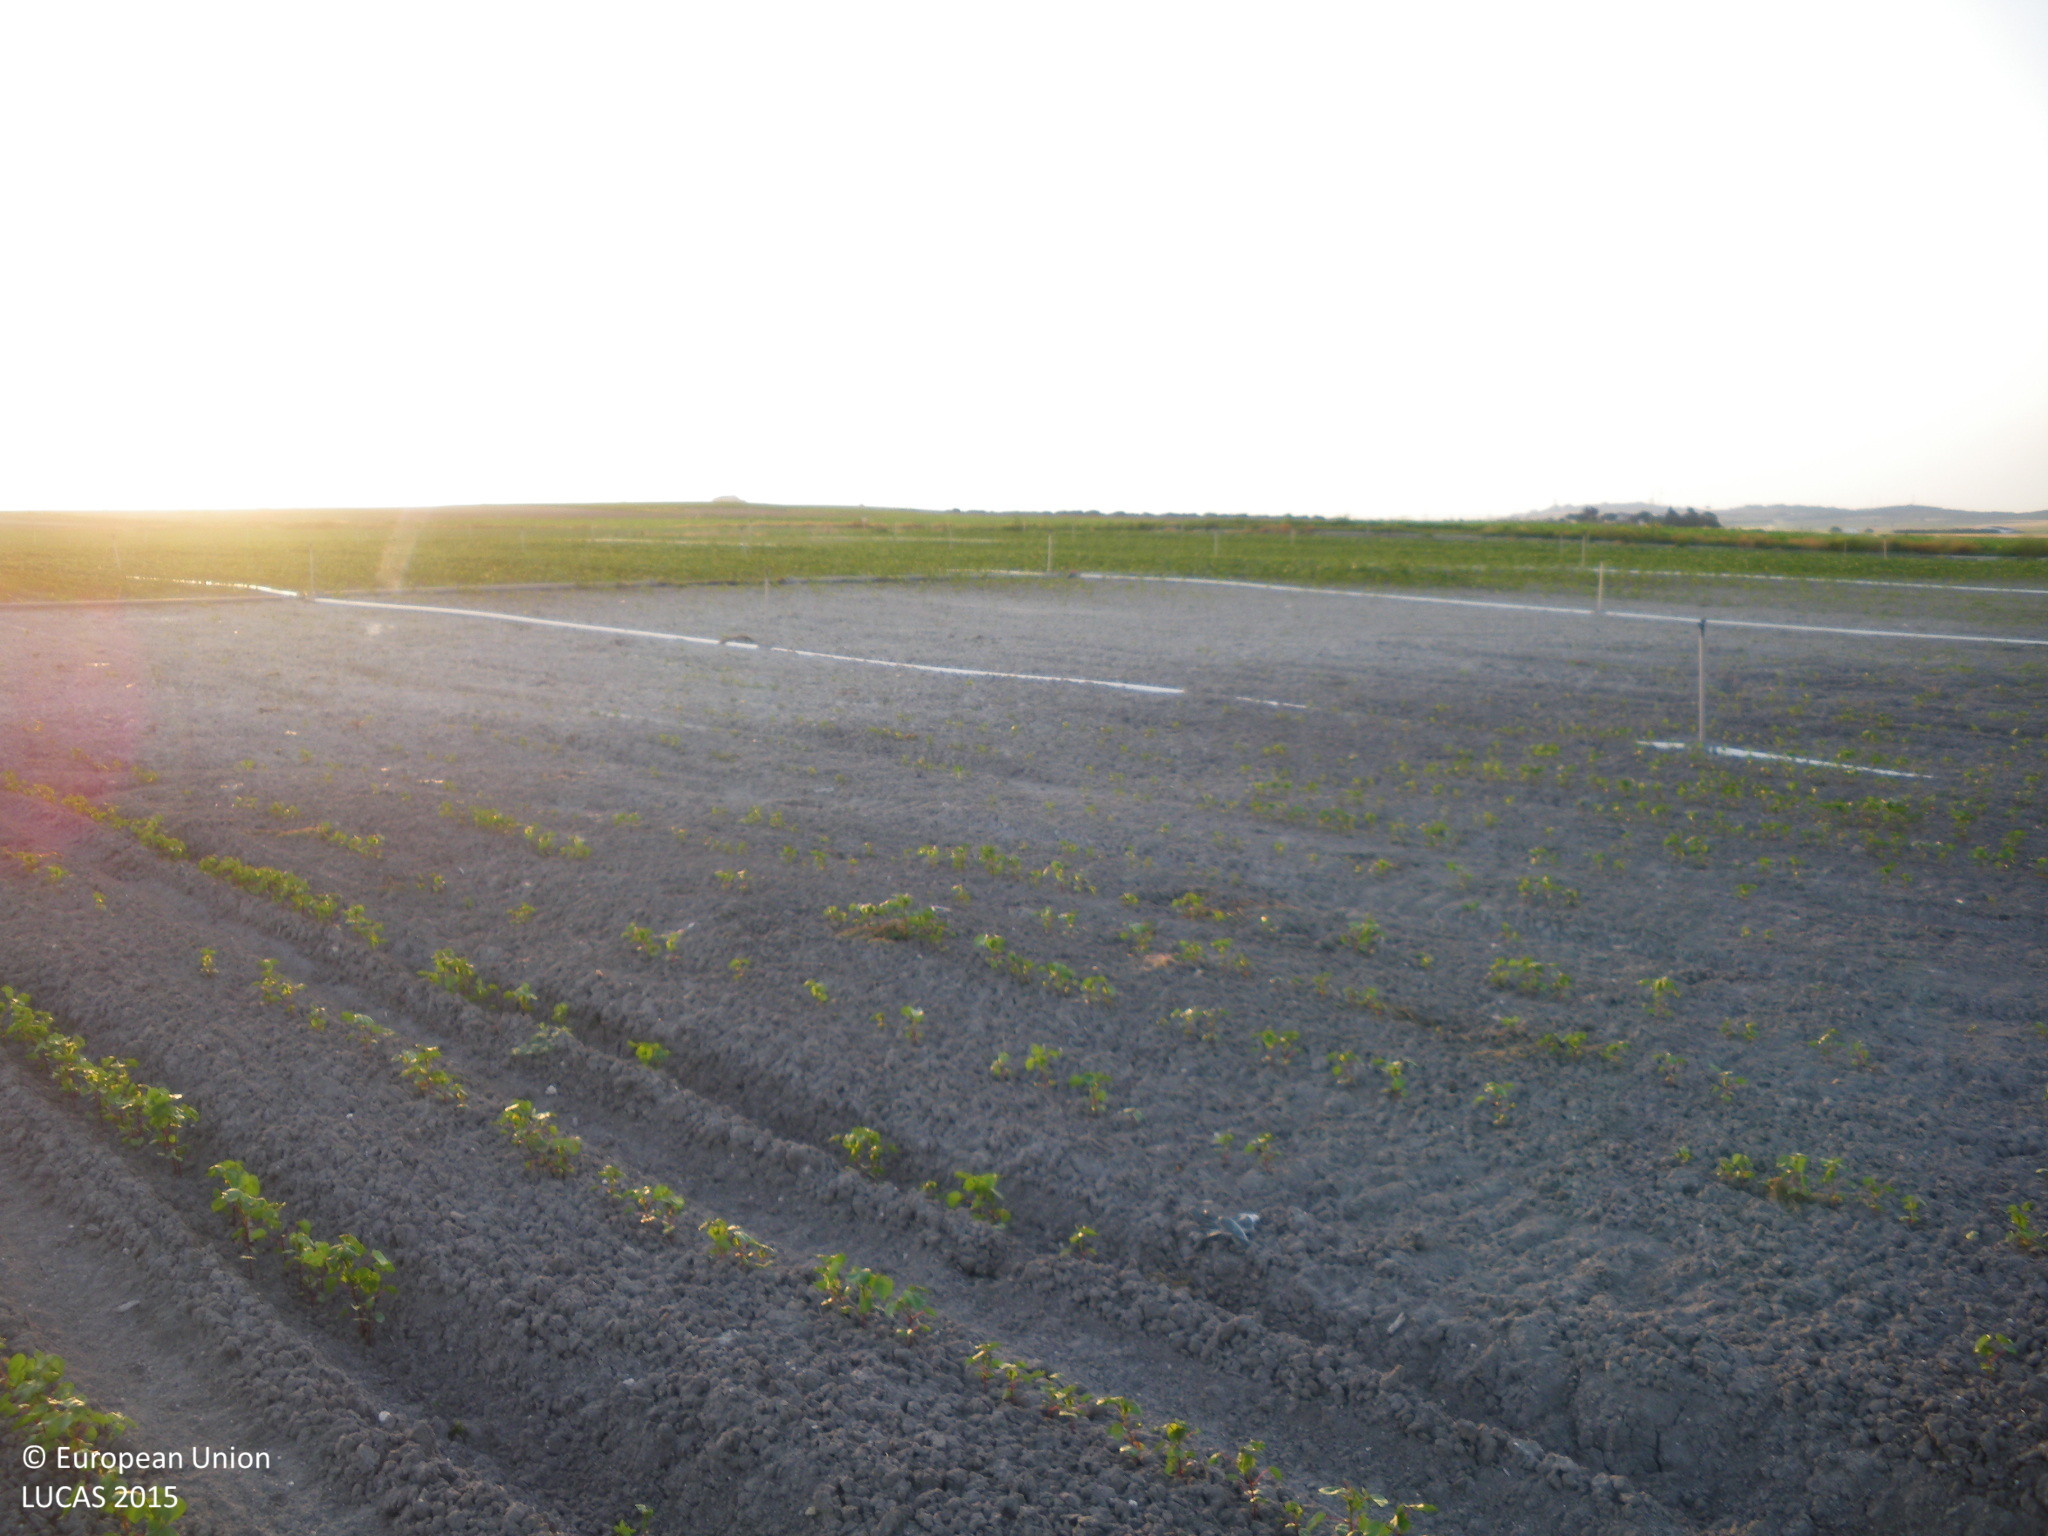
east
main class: Cropland
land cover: Cotton
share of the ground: < 10 %
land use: Agriculture (excluding fallow land and kitchen gardens)
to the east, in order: Cotton; Artificial constructions; Grass margins; Fences; Sugar beet; Artificial constructions; Fences; Cotton
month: June
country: ES
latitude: 36.6543
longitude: -6.2451
